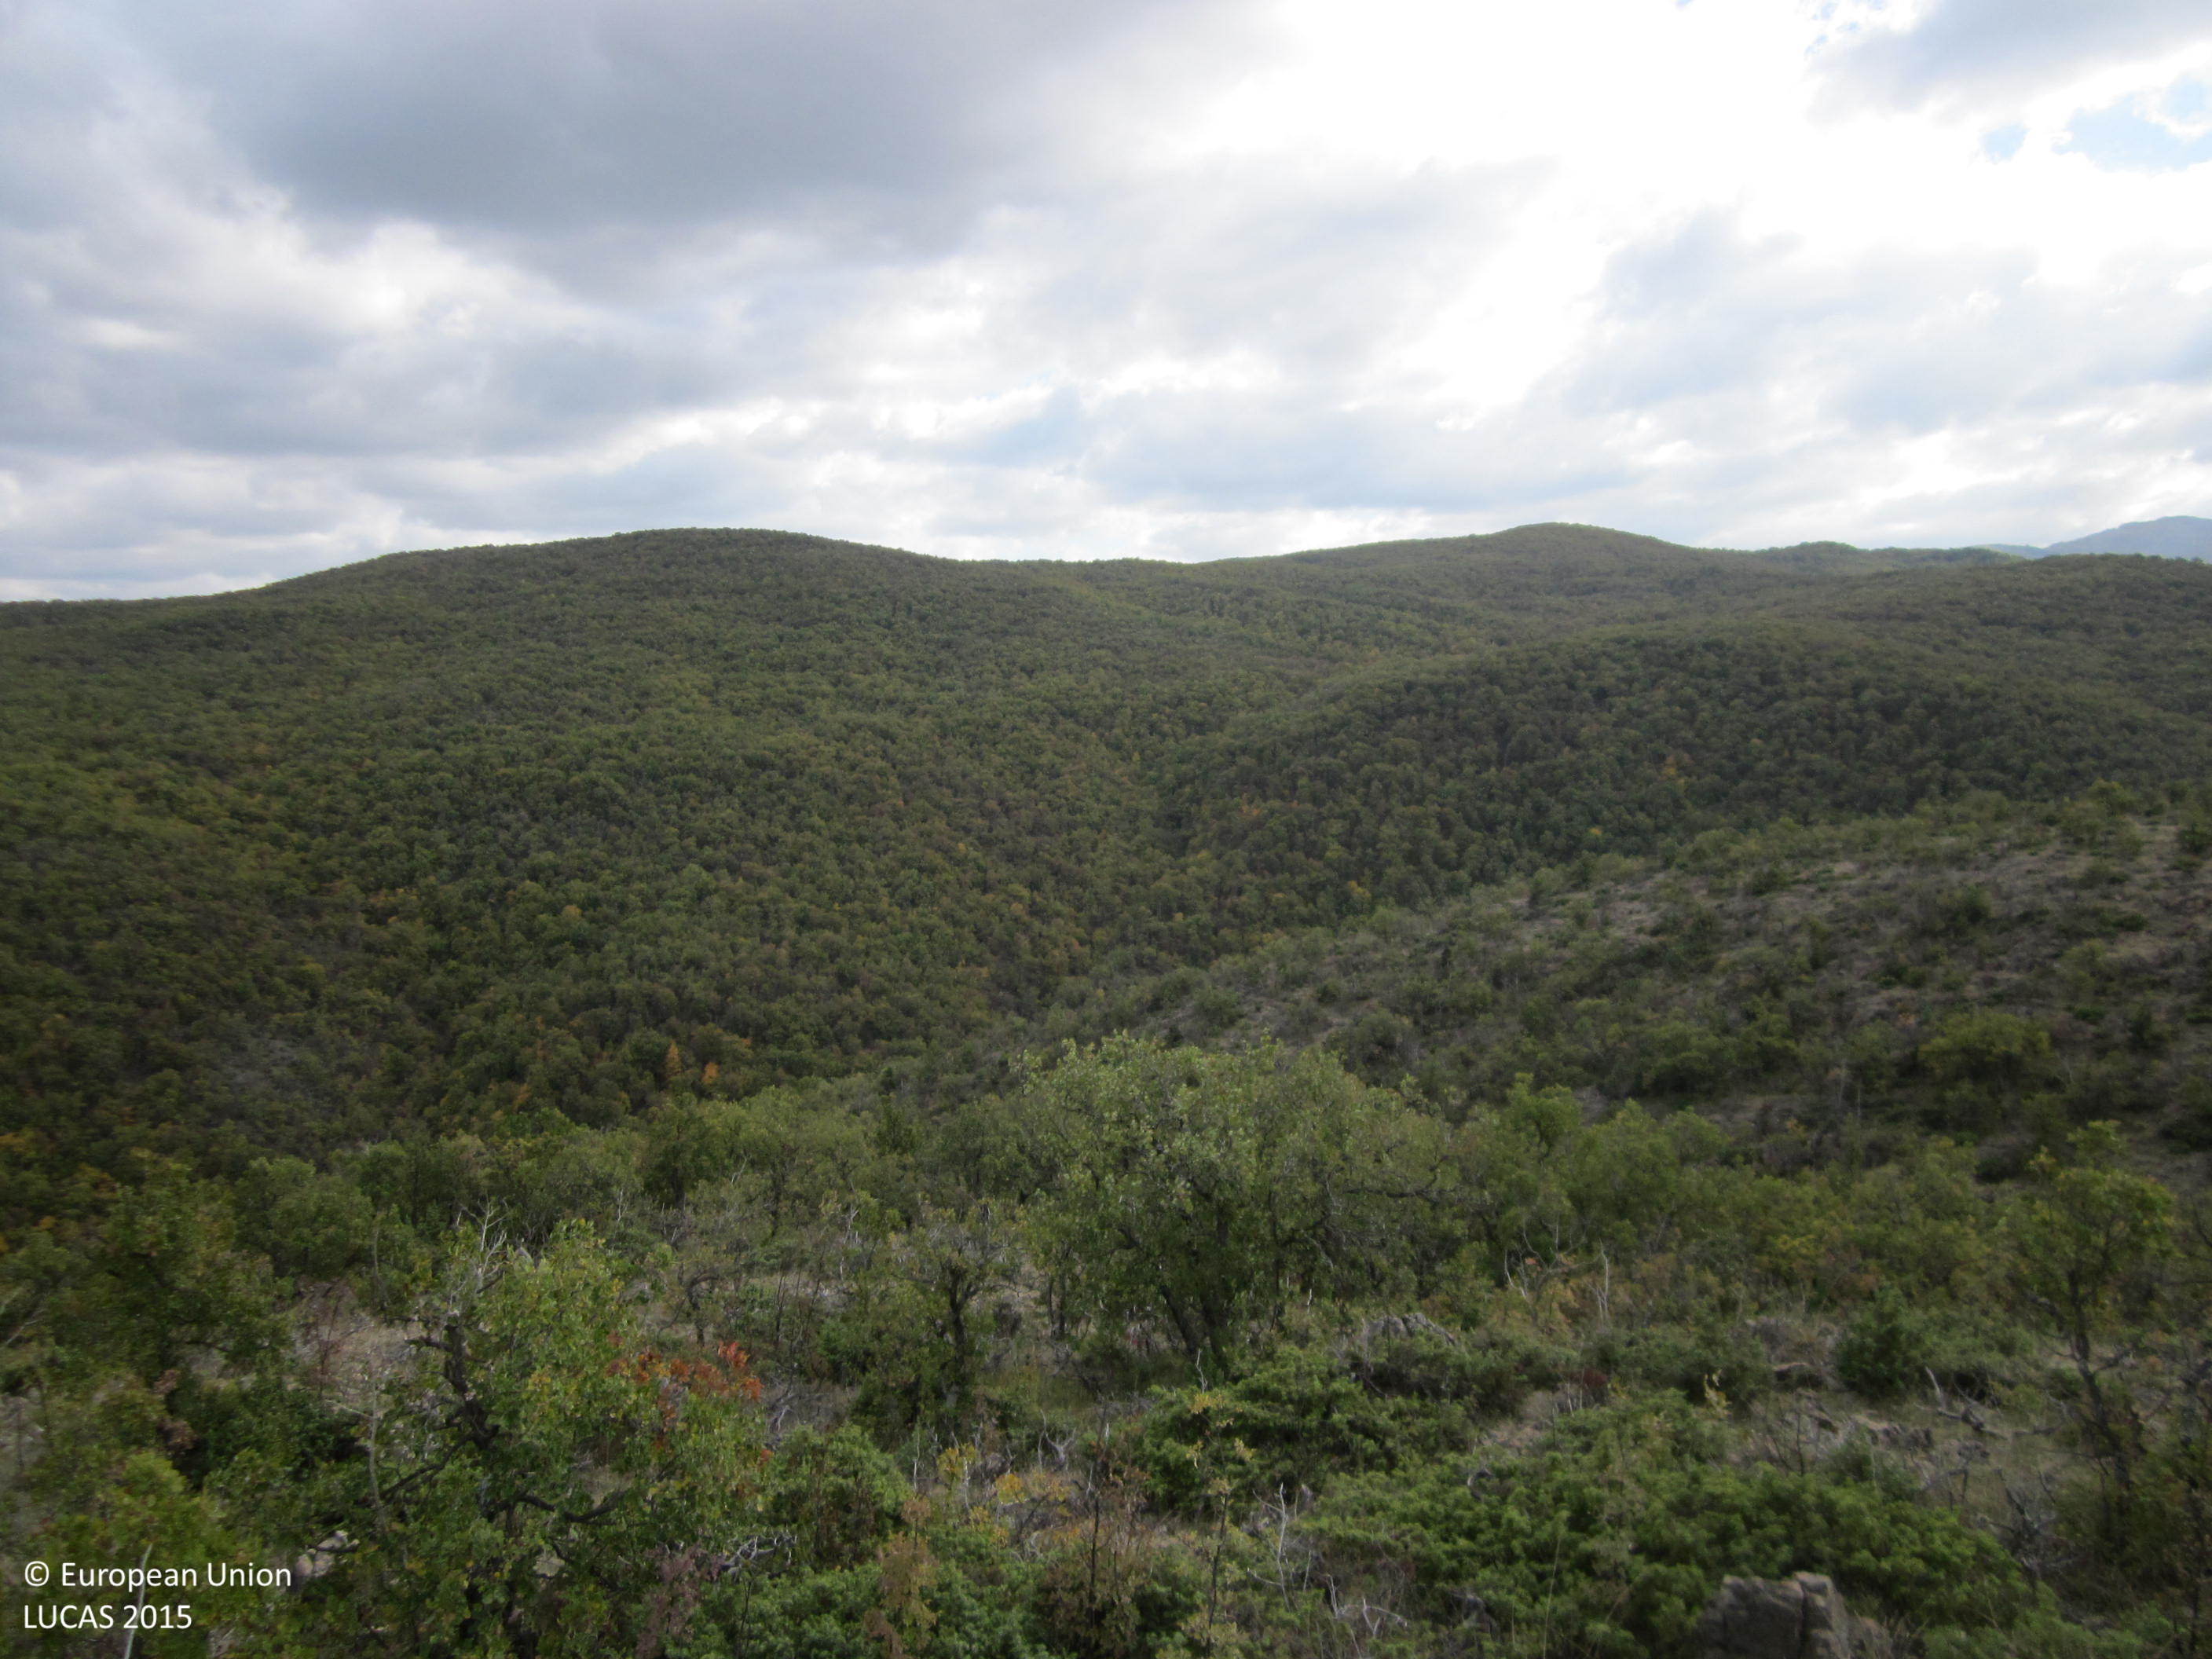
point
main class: Woodland
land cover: Broadleaved woodland
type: mesophytic deciduous forest
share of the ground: > 75 %
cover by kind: broadleaved forest trees 100 %
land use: Forestry
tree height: > 5 m
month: November
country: BG
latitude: 41.4085
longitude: 25.8908
